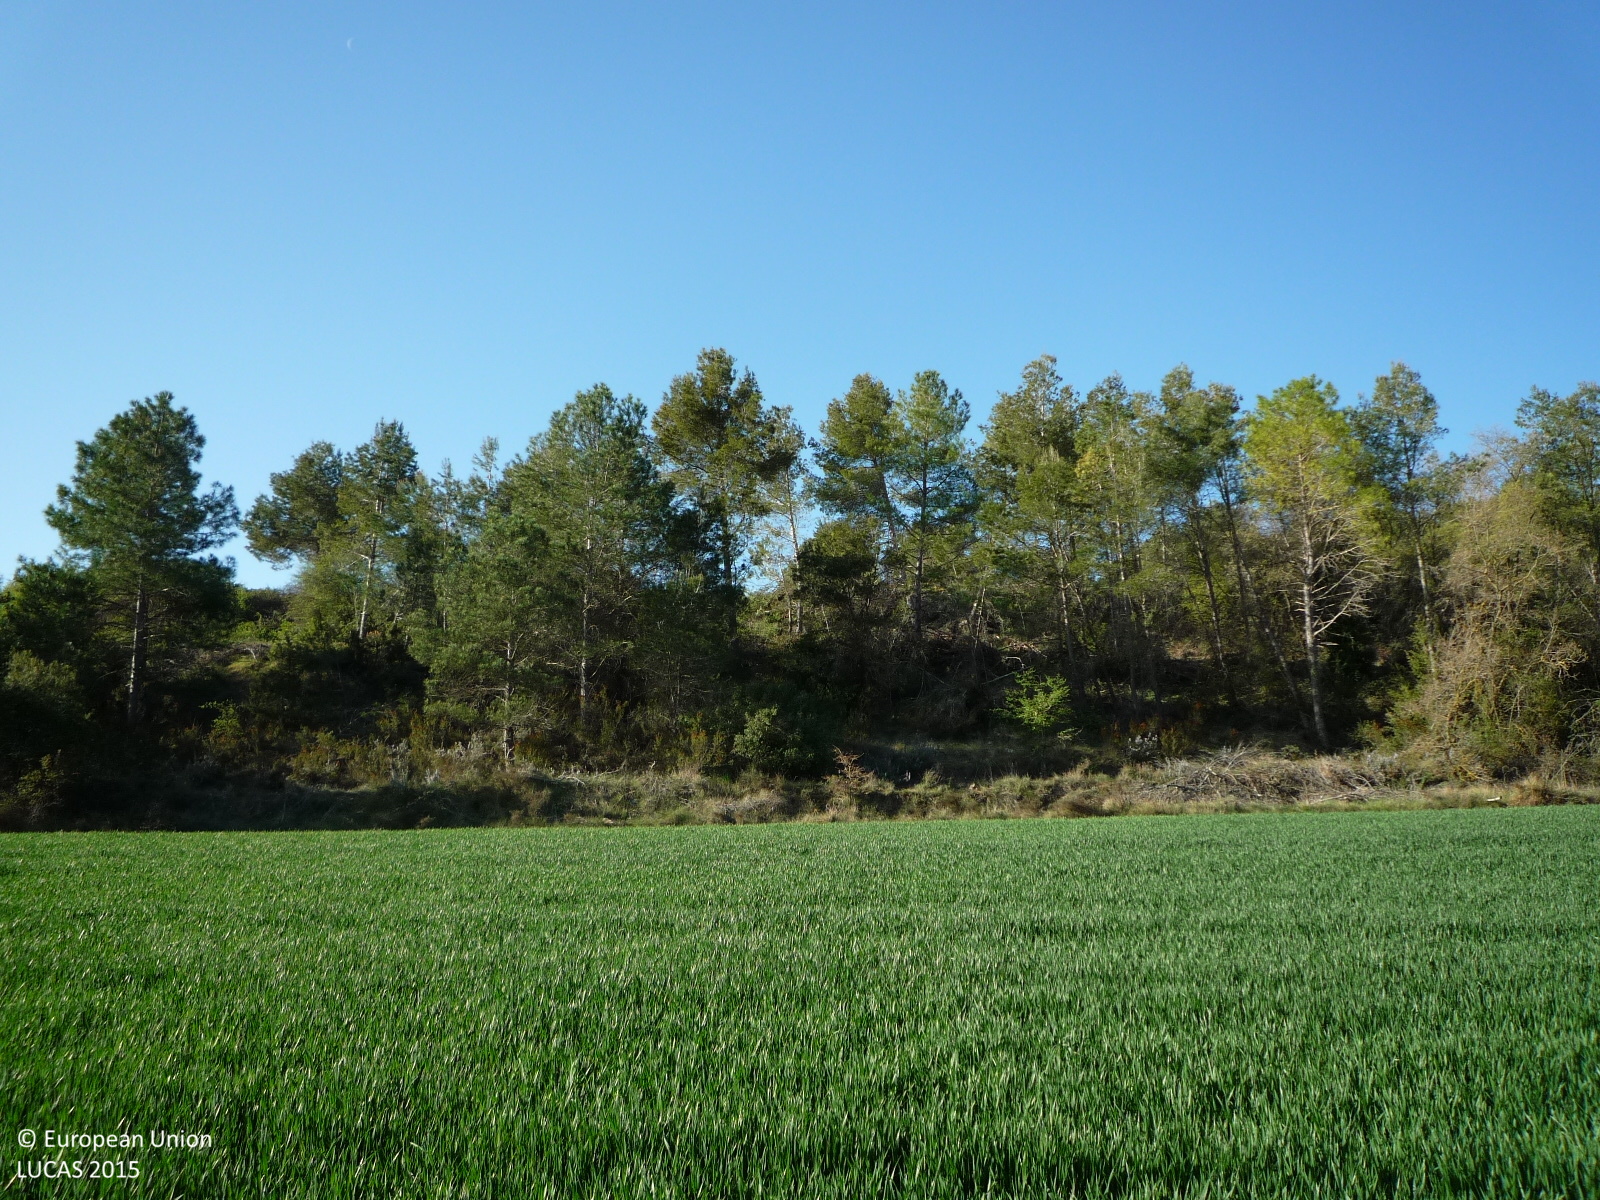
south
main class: Cropland
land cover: Common wheat
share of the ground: > 75 %
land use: Agriculture (excluding fallow land and kitchen gardens)
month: April
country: ES
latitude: 41.4972
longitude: 1.4988
